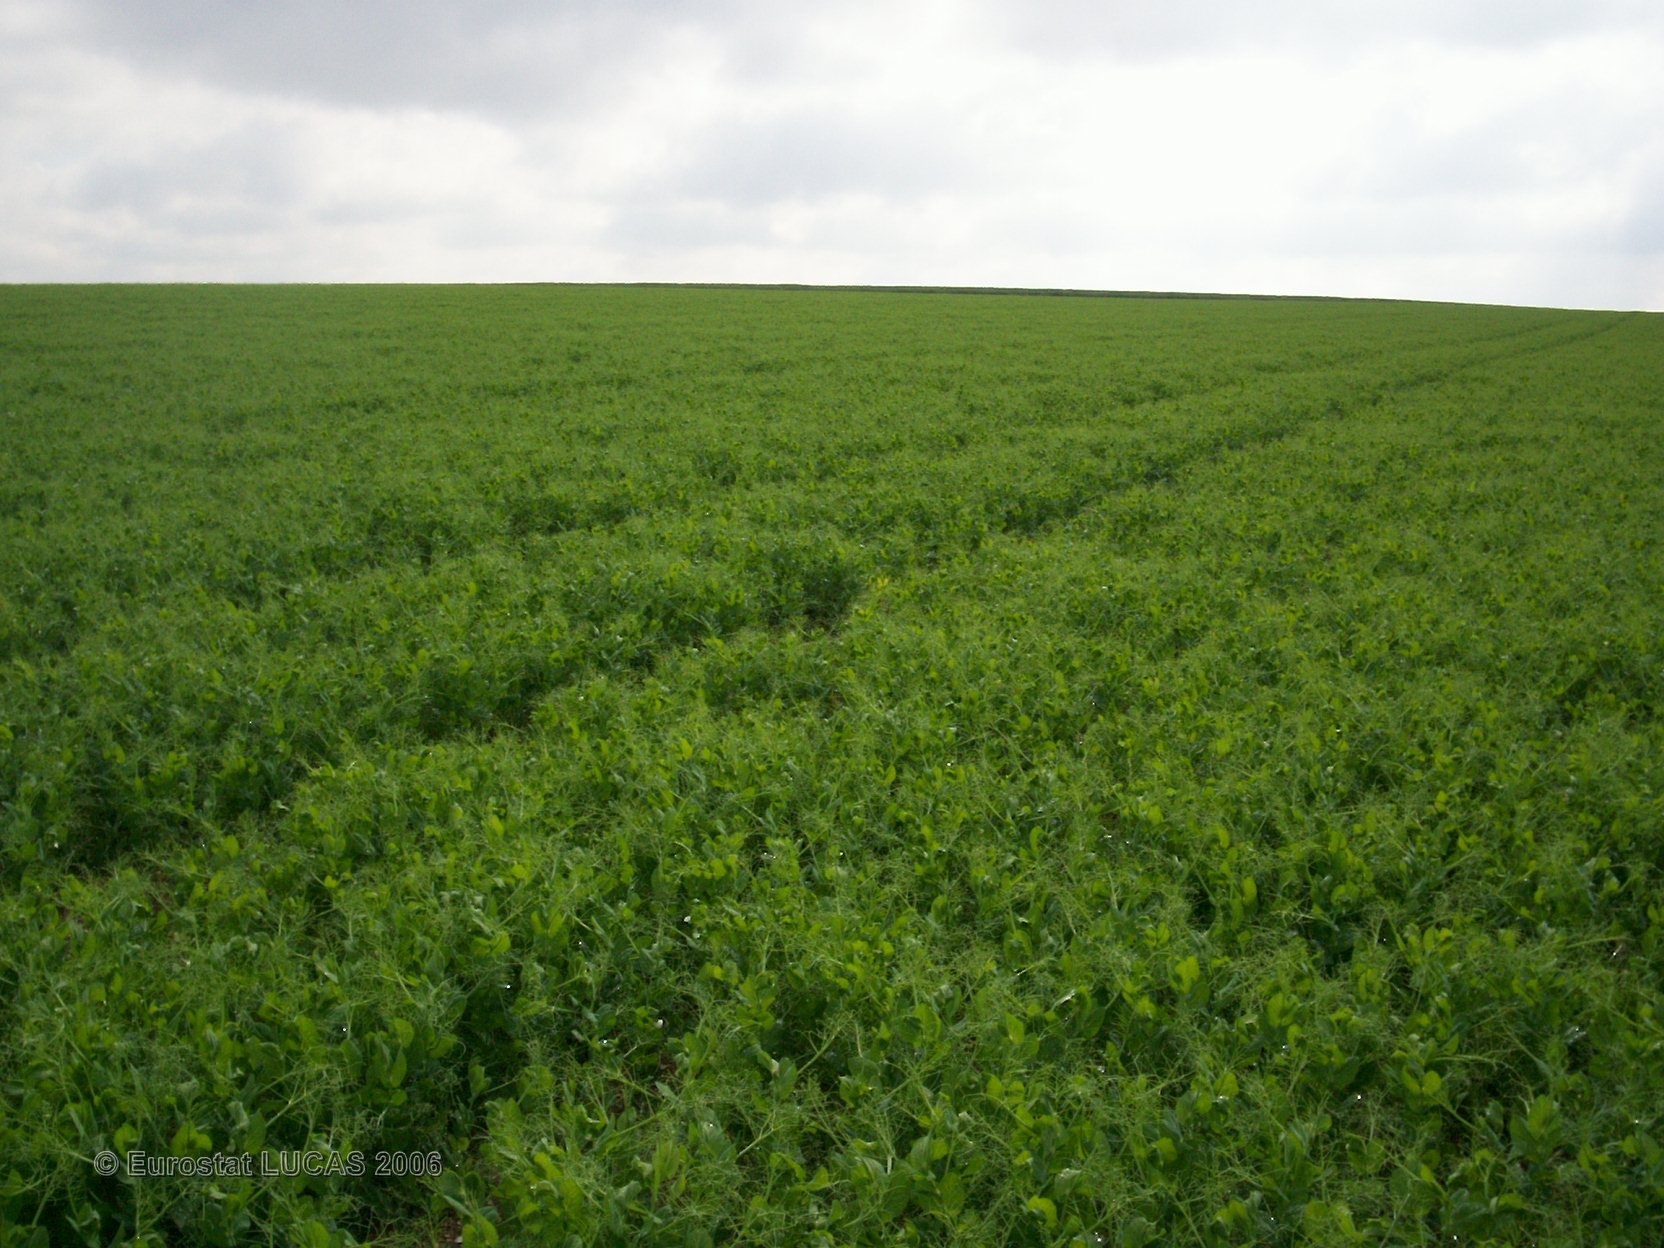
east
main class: Cropland
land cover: Dry pulses
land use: Agriculture (excluding fallow land and kitchen gardens)
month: June
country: FR
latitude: 48.5696
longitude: 4.4270
